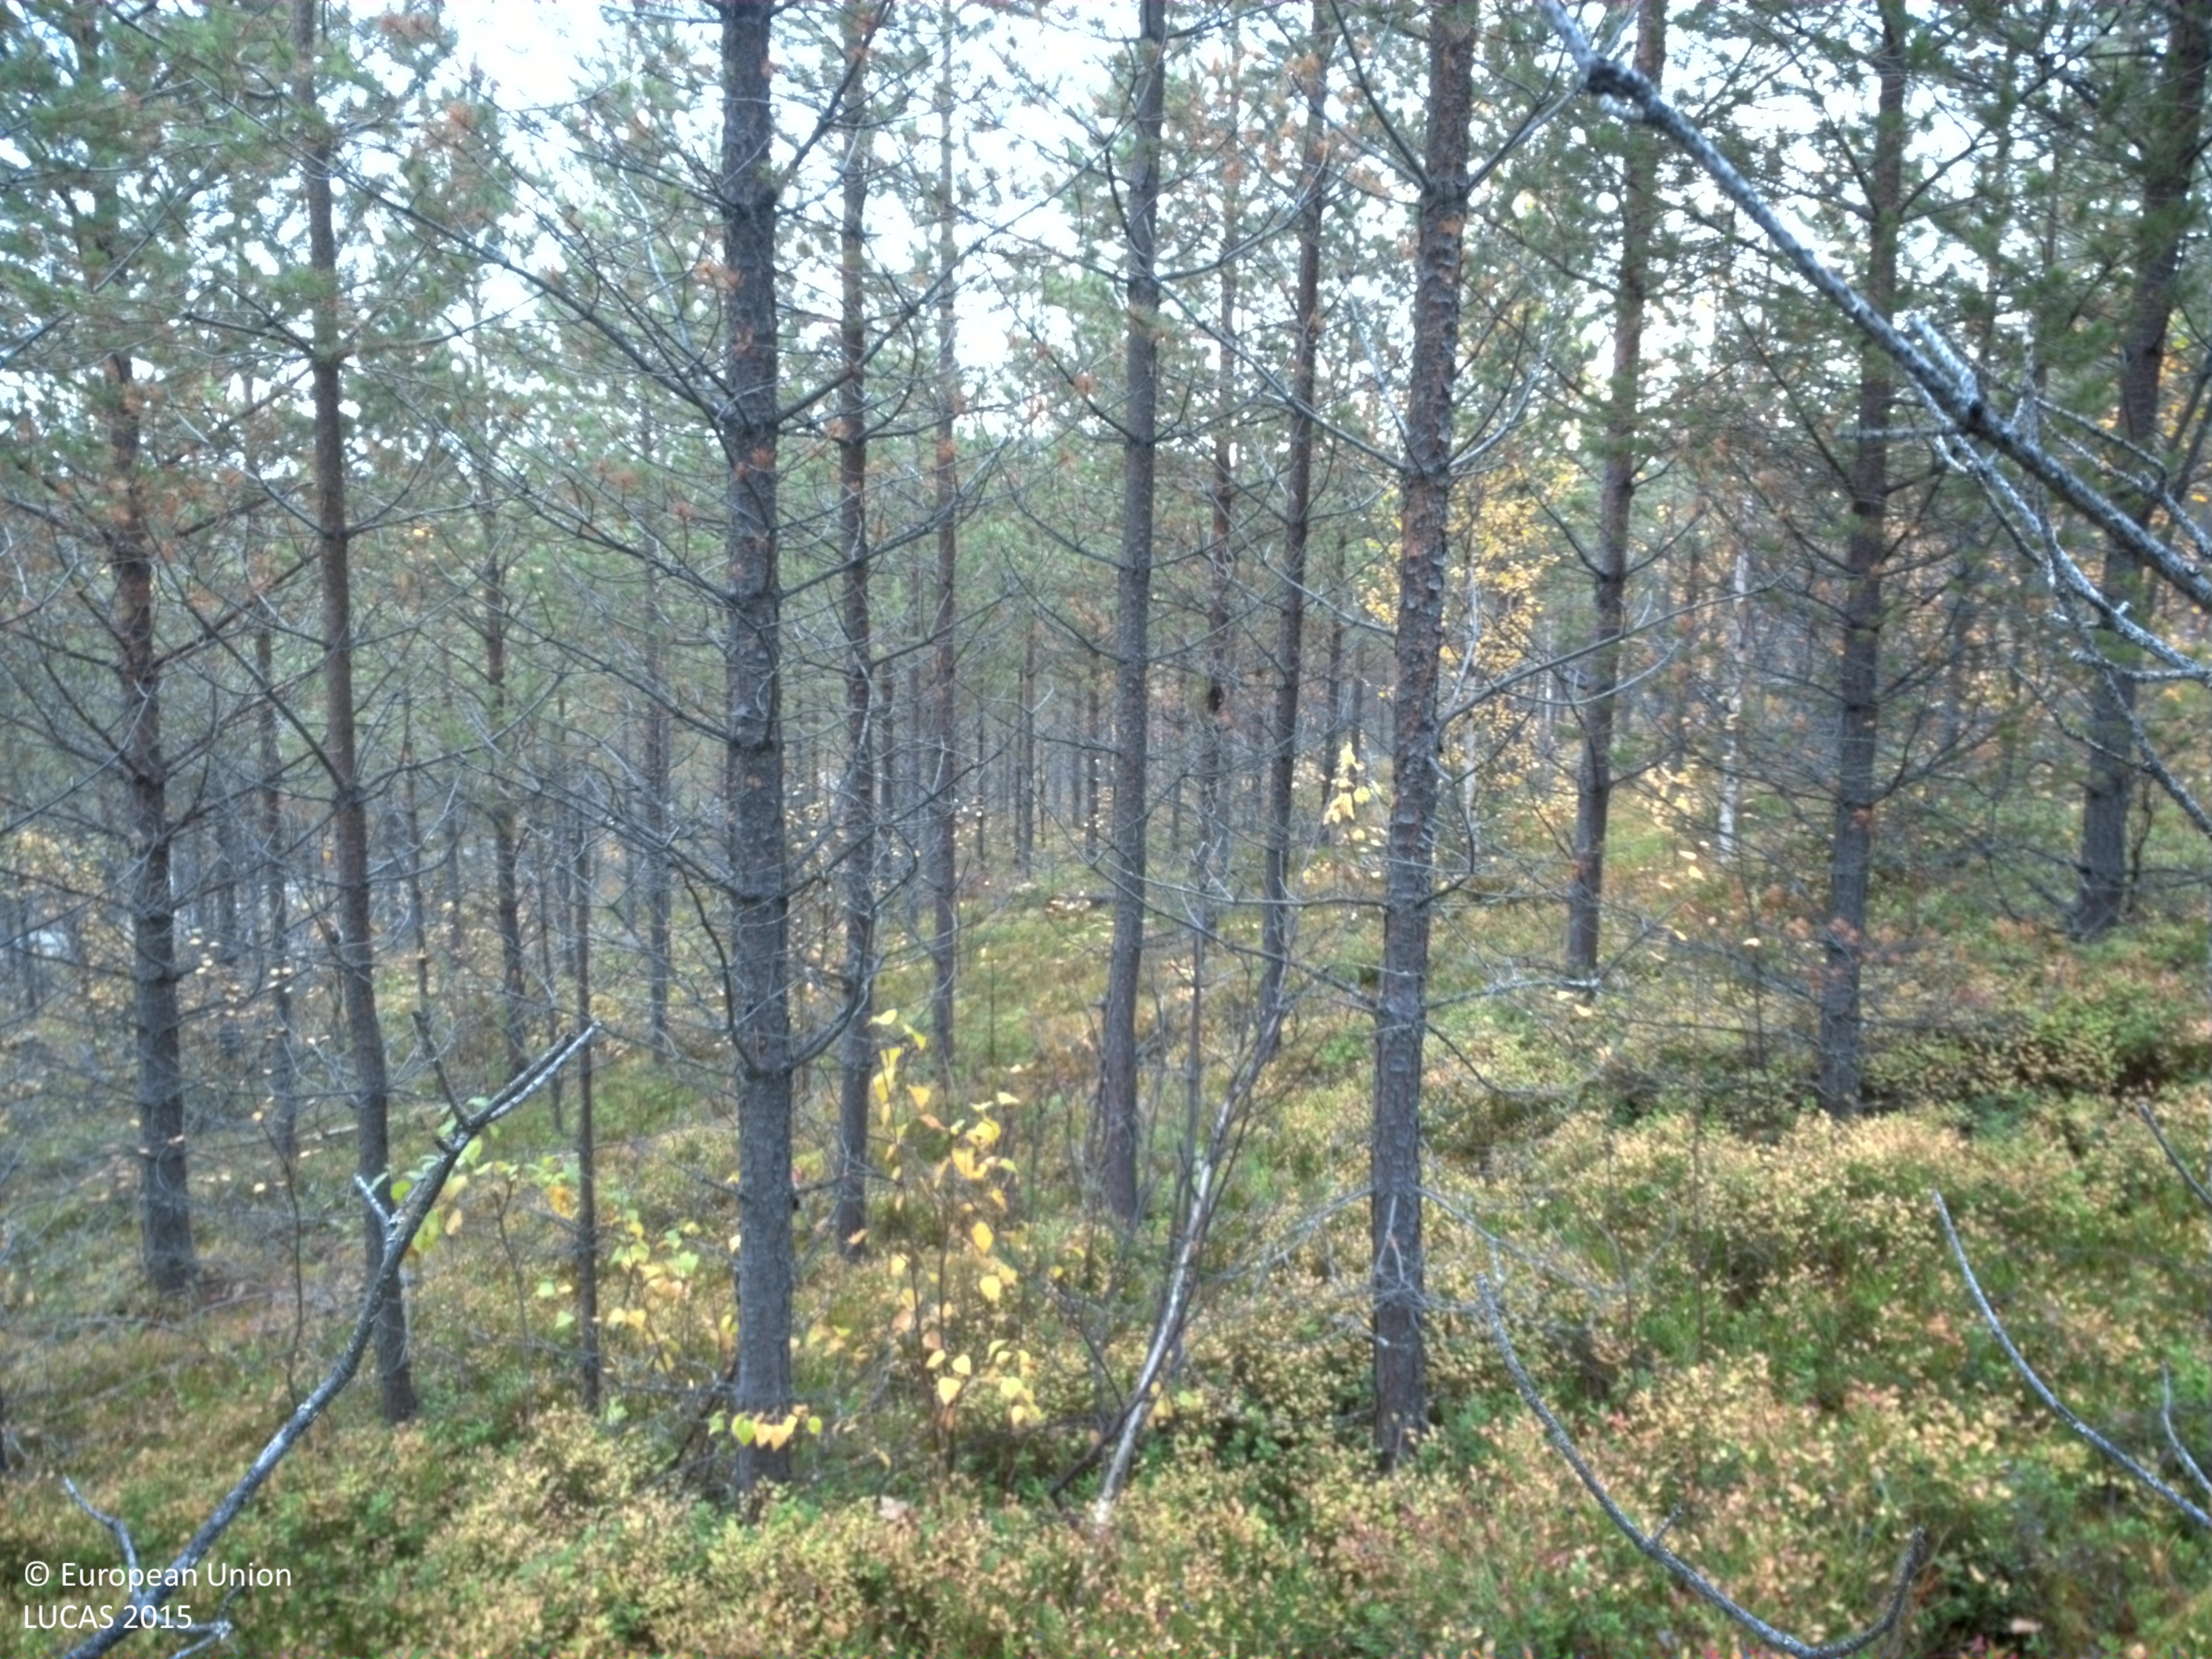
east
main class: Woodland
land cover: Pine dominated coniferous woodland
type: boreal forest
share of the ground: 25 - 50 %
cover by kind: coniferous forest trees 40 %, shrubs 40 %, lichens and mosses 15 %, broadleaved forest trees 5 %
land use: Forestry
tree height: > 5 m
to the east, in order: Pine dominated coniferous woodland; Pine dominated mixed woodland; Groves; Ditches and canals; Shruby margins; Paved roads, cycling and walking lanes; Shruby margins; Spruce dominated mixed woodland; Pine dominated mixed woodland; Rivers and streams
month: September
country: SE
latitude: 64.8984
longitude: 17.7600
